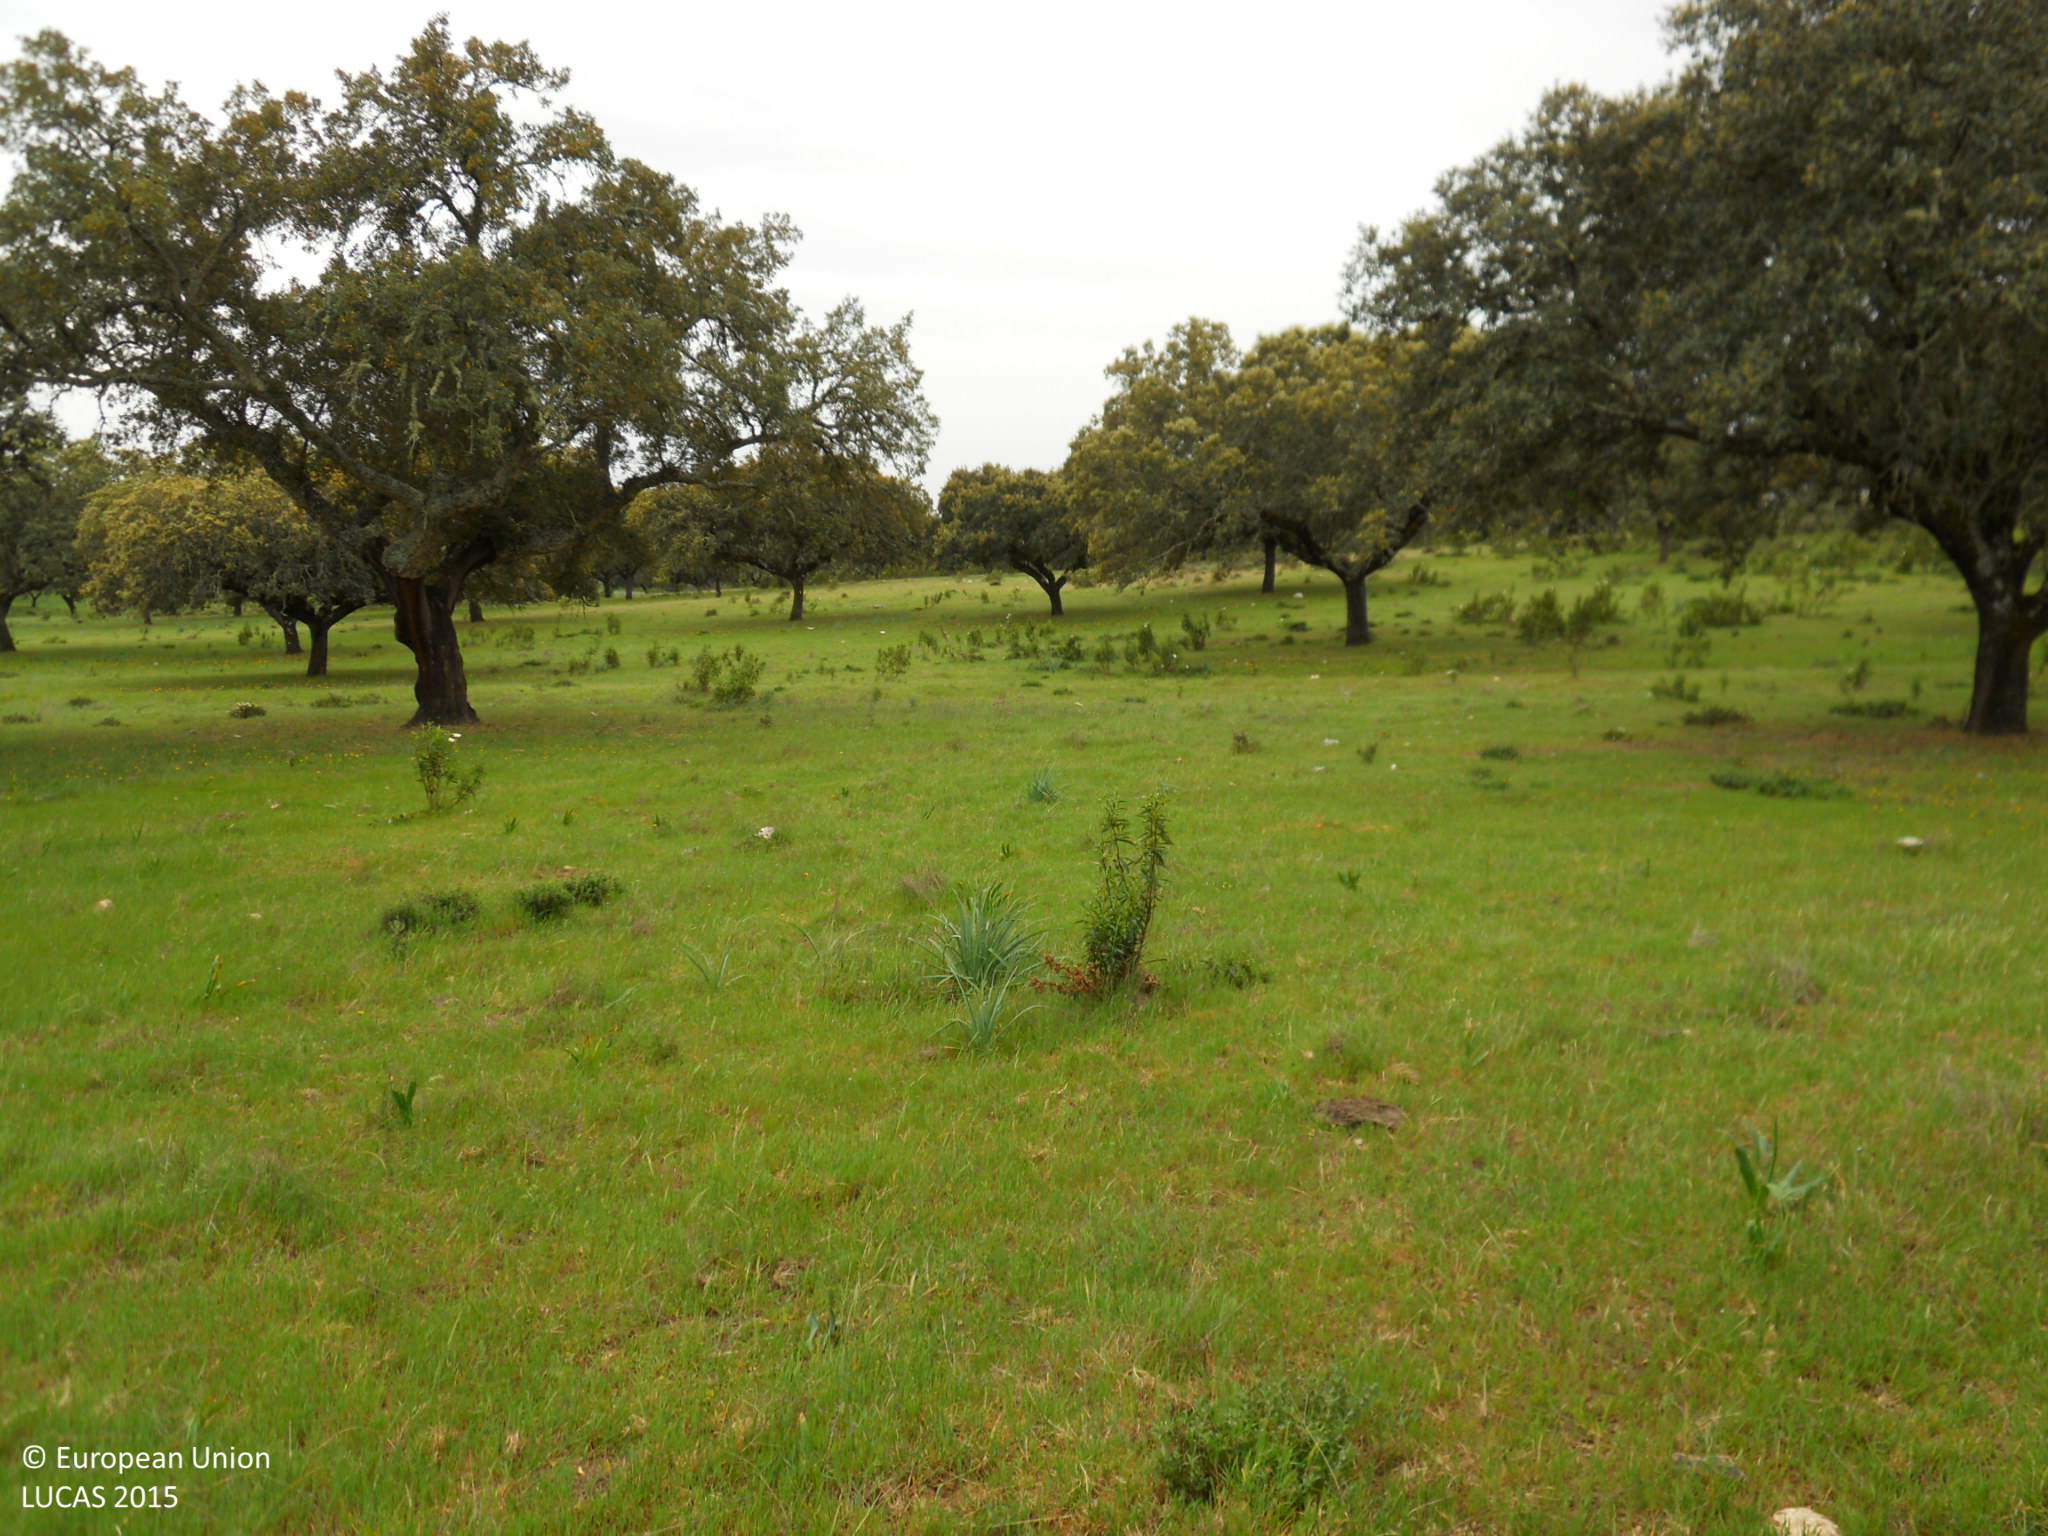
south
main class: Woodland
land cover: Broadleaved woodland
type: broadleaved evergreen forest
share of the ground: > 75 %
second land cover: Grassland without tree/shrub cover
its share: > 75 %
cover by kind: broadleaved forest trees 50 %, herbaceous plants 50 %
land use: Forestry
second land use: Agriculture (excluding fallow land and kitchen gardens)
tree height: > 5 m
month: April
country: ES
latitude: 39.1371
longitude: -6.5989
